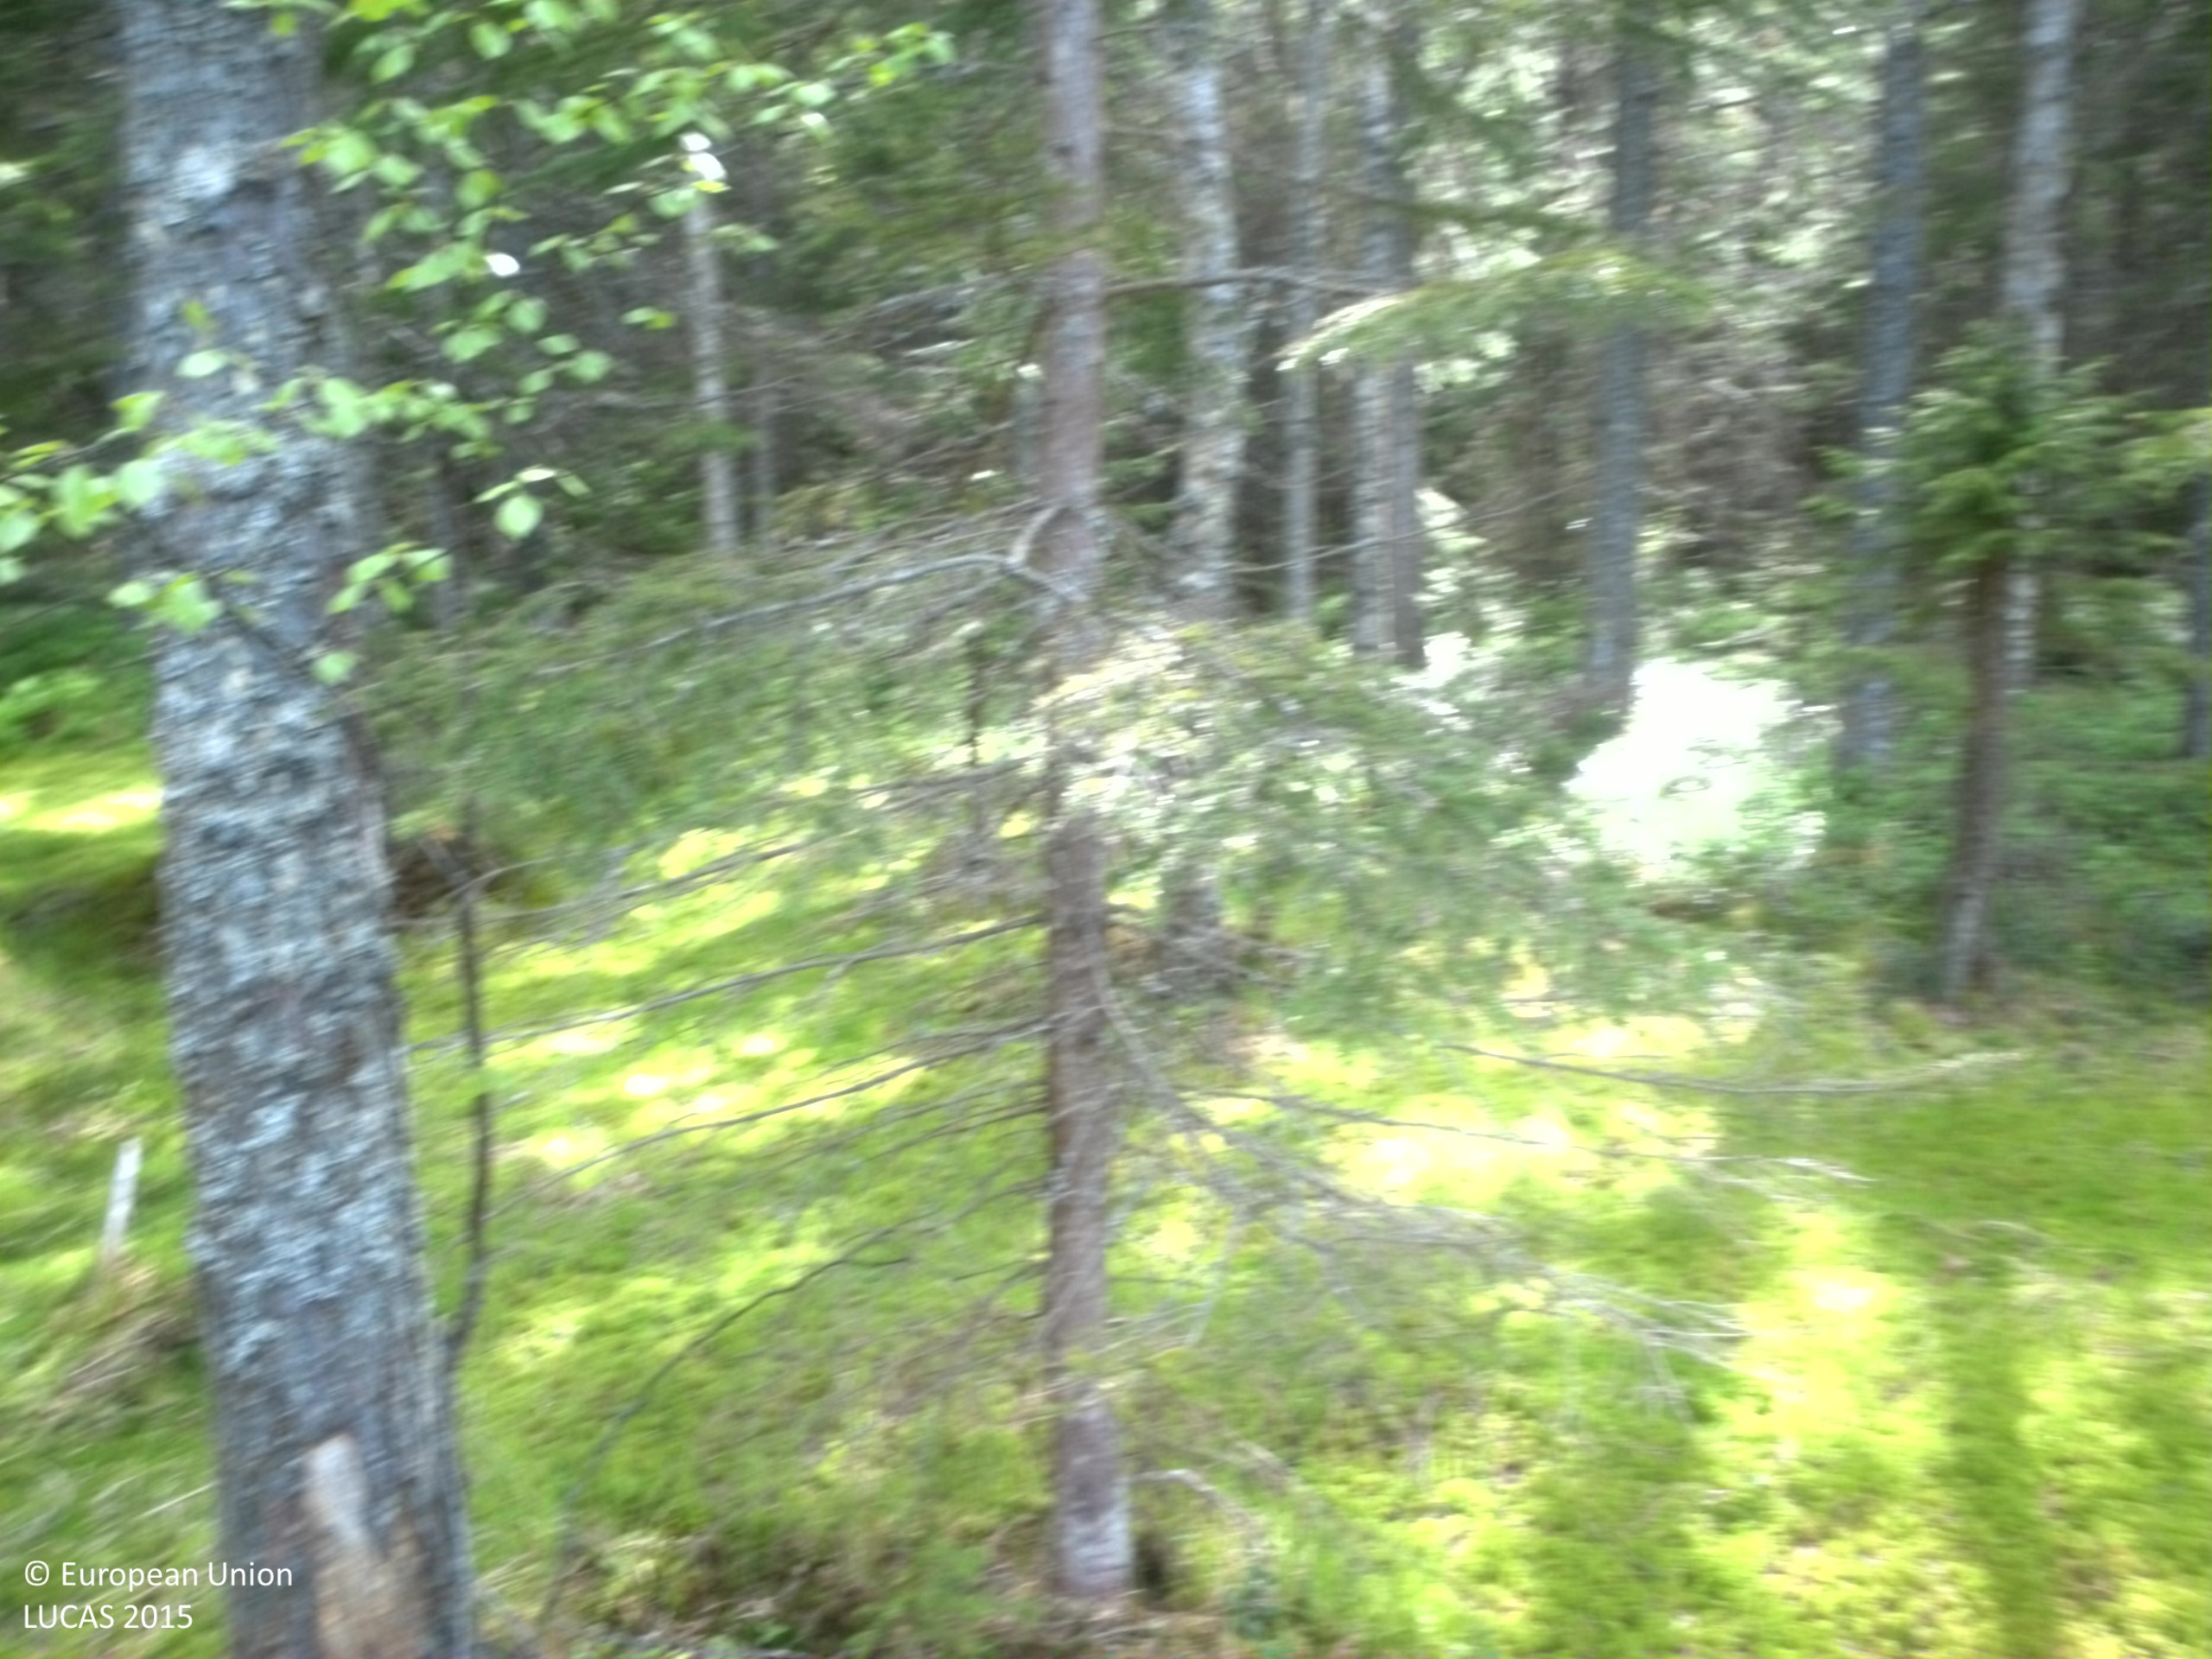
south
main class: Woodland
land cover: Spruce dominated mixed woodland
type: boreal forest
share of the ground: 50 - 75 %
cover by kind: coniferous forest trees 45 %, lichens and mosses 30 %, broadleaved forest trees 15 %, shrubs 10 %
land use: Forestry
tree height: > 5 m
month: June
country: SE
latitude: 62.9080
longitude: 17.9892
